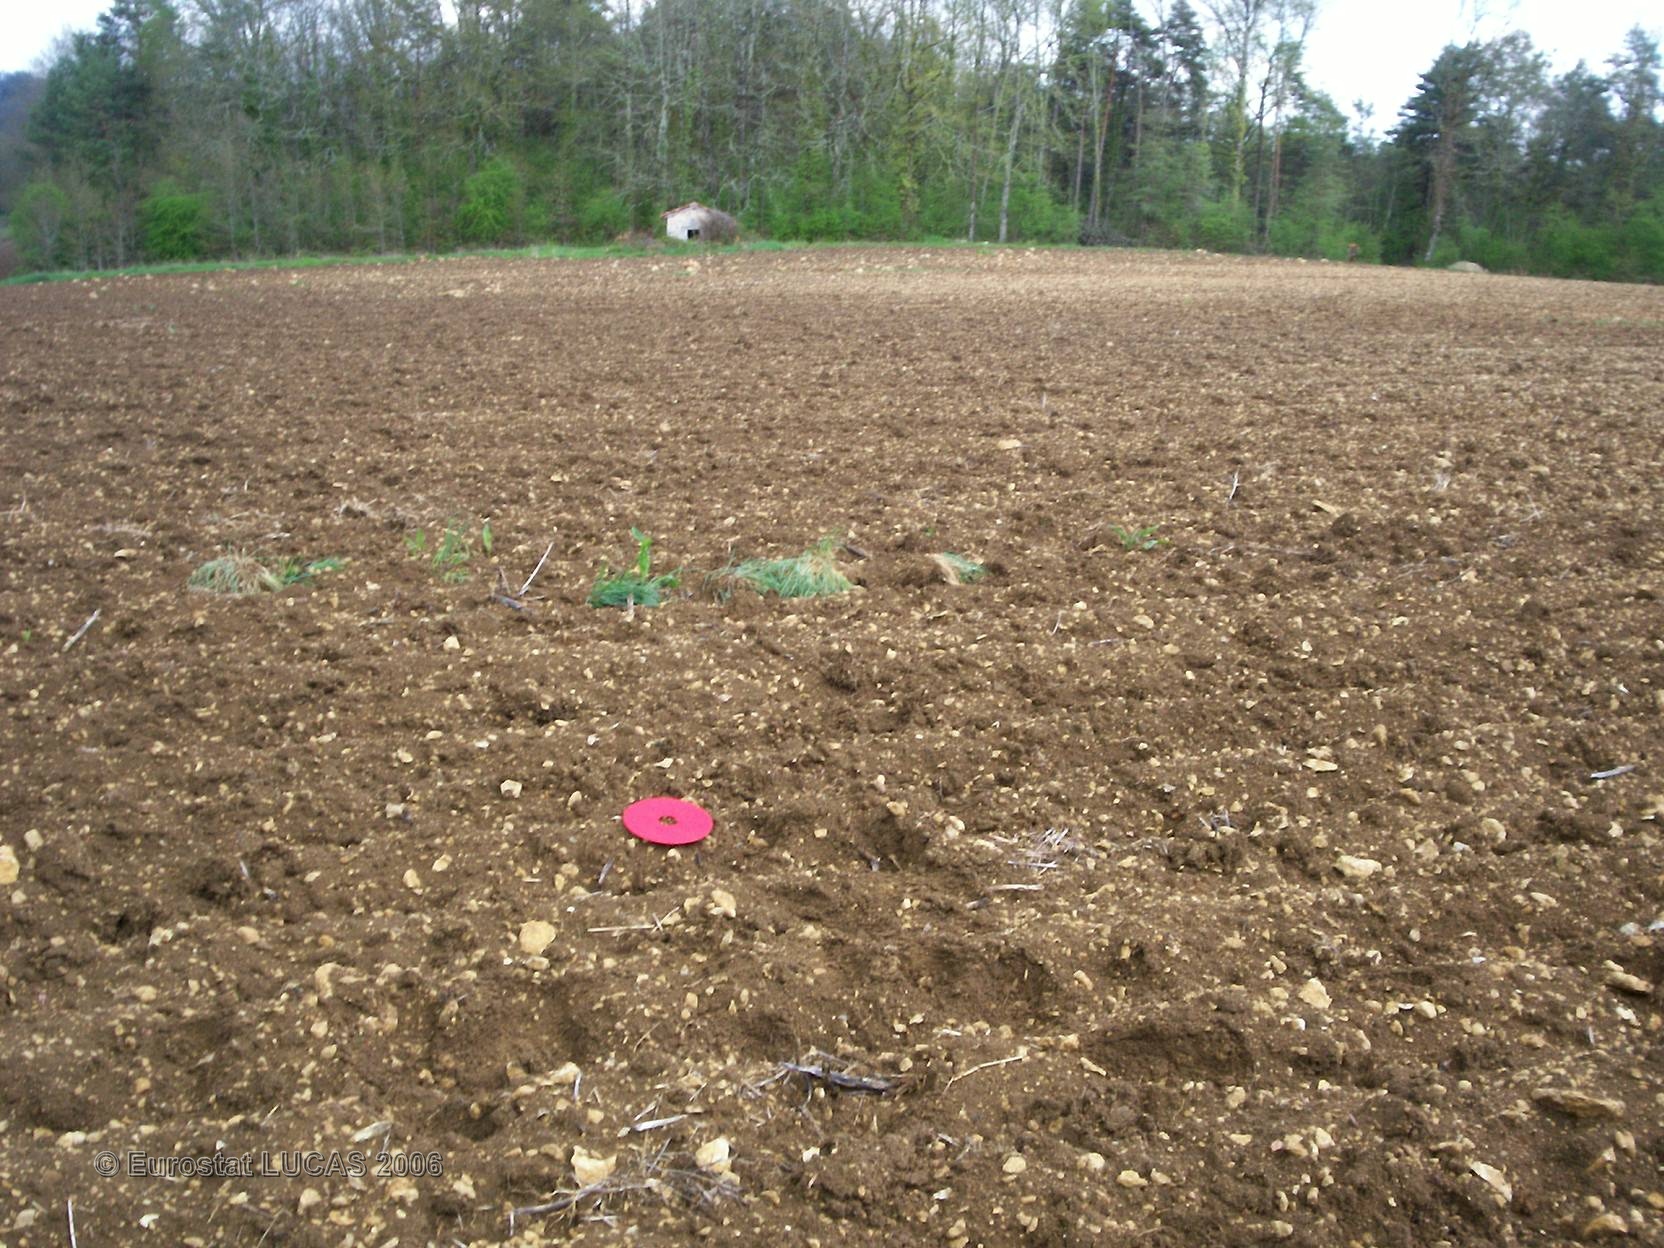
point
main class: Cropland
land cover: Maize
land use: Agriculture (excluding fallow land and kitchen gardens)
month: June
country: FR
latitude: 45.3881
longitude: 0.7550
